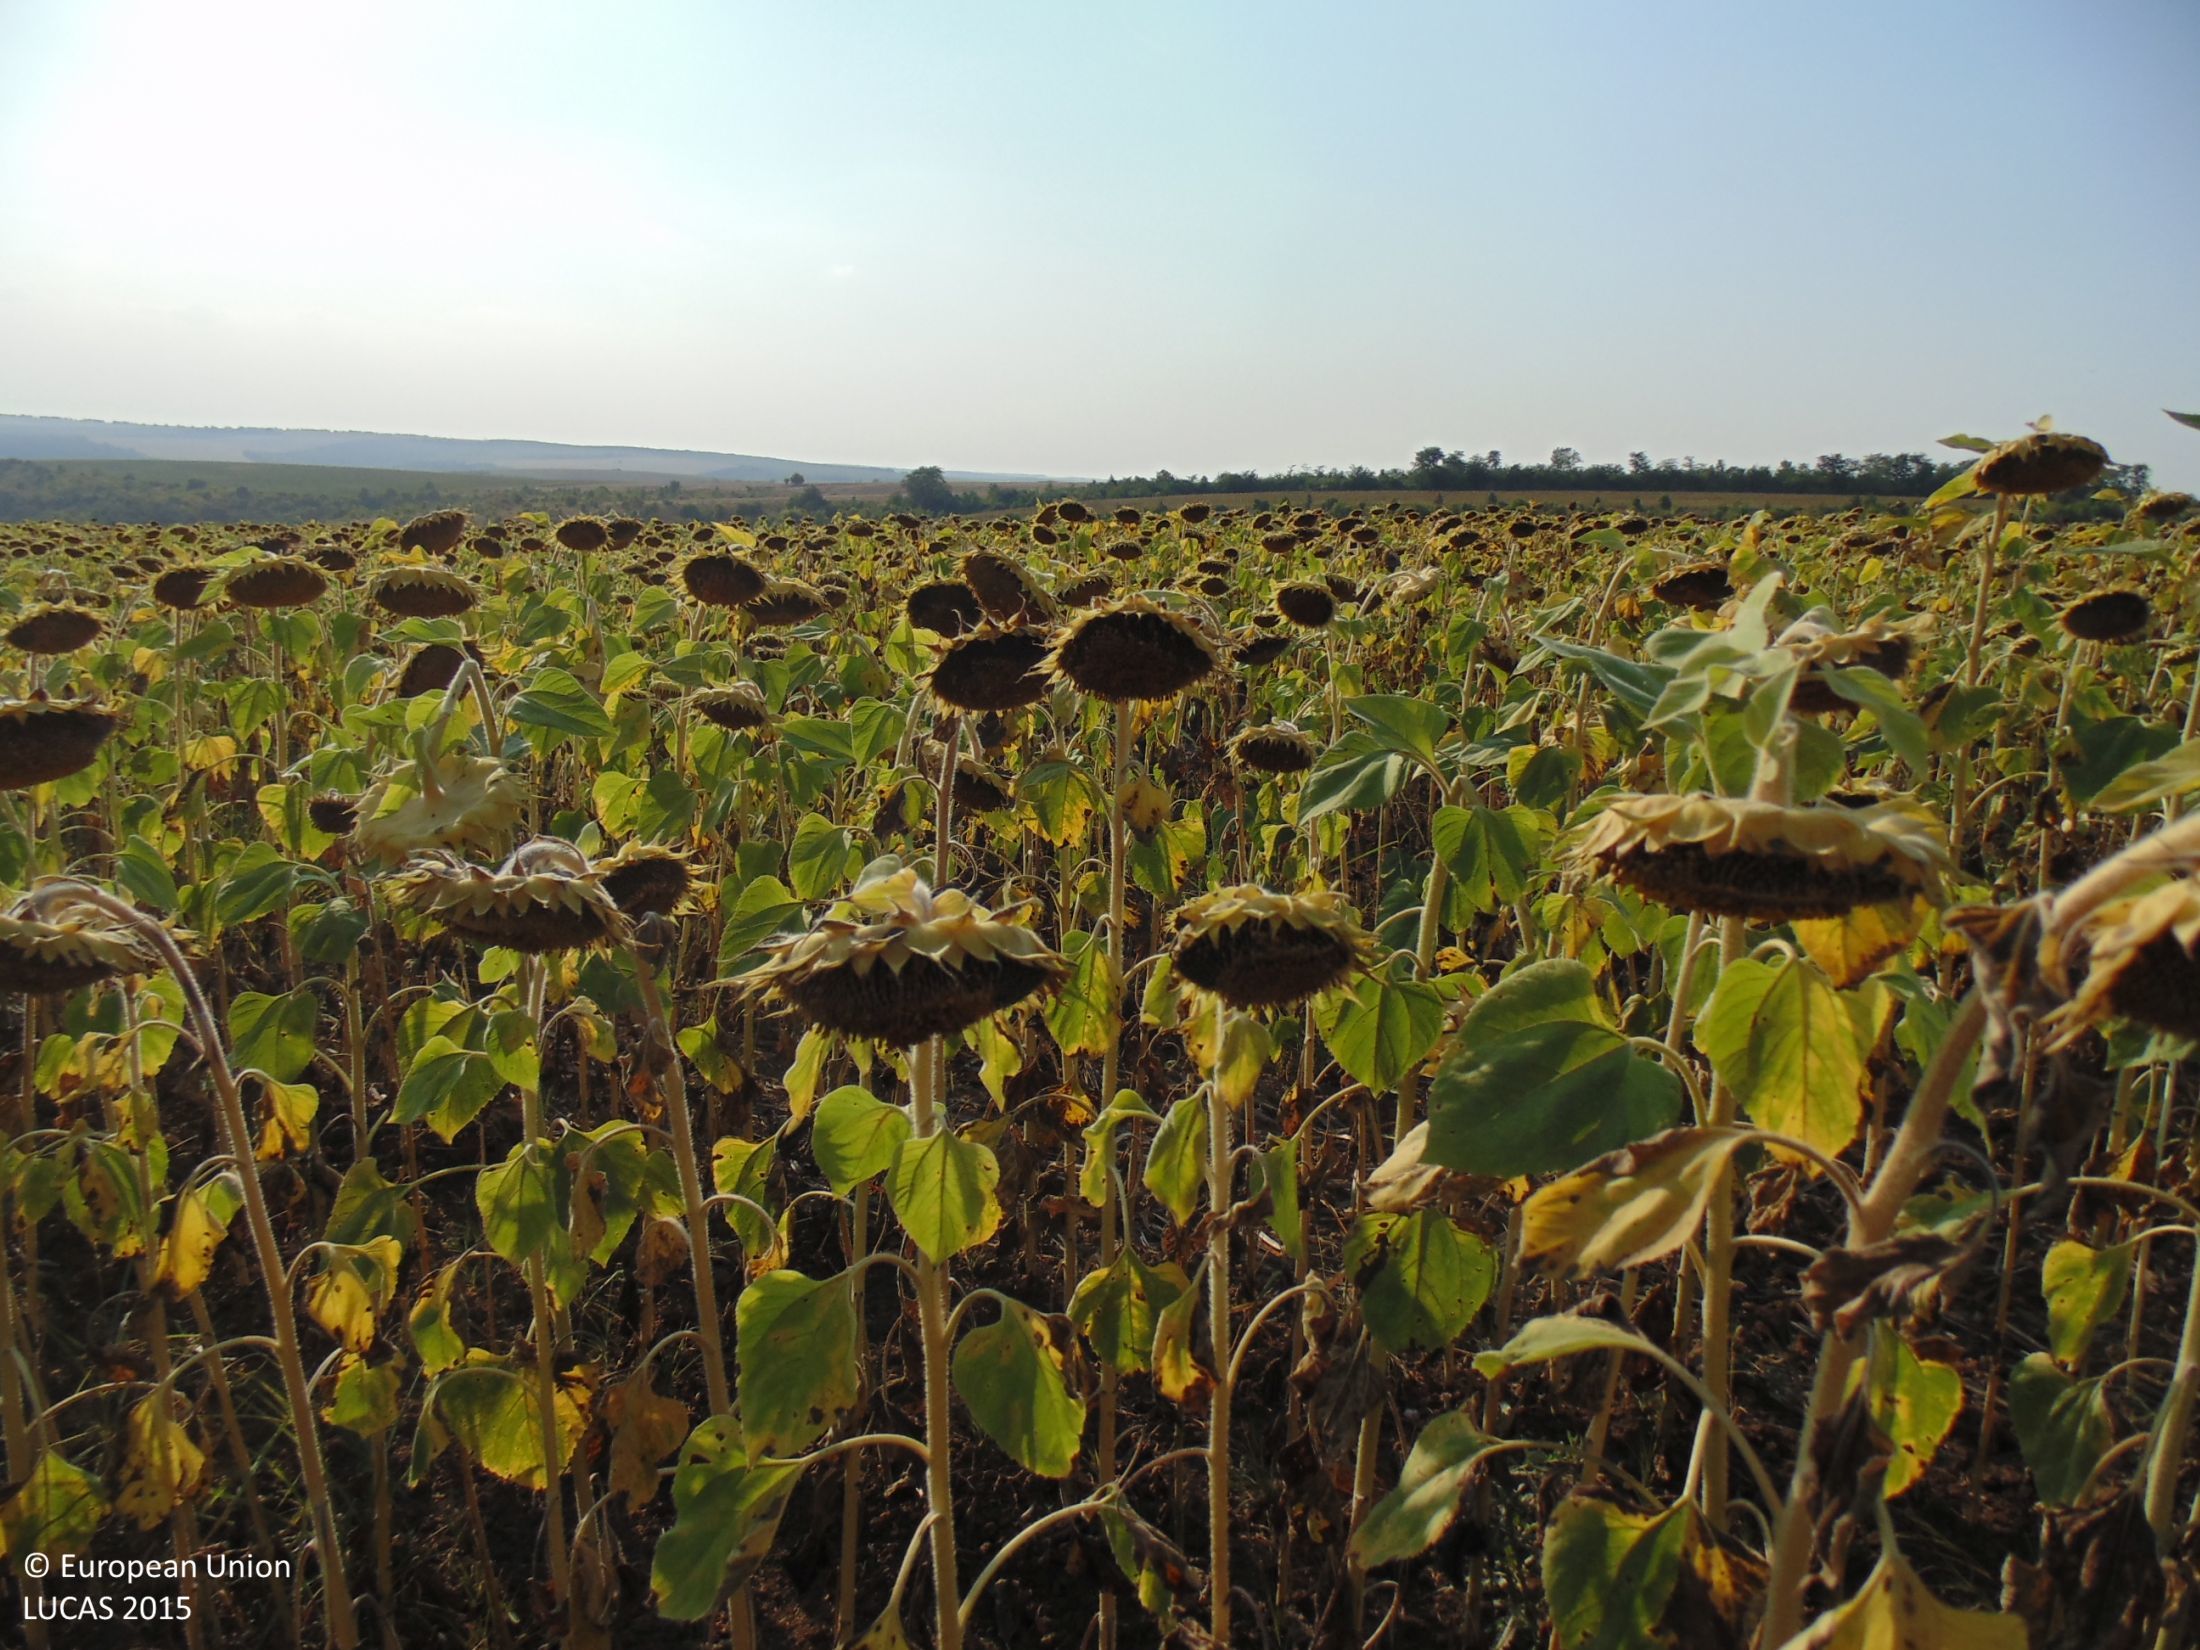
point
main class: Cropland
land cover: Sunflower
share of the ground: > 75 %
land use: Agriculture (excluding fallow land and kitchen gardens)
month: August
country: BG
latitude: 43.8813
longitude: 27.4979
